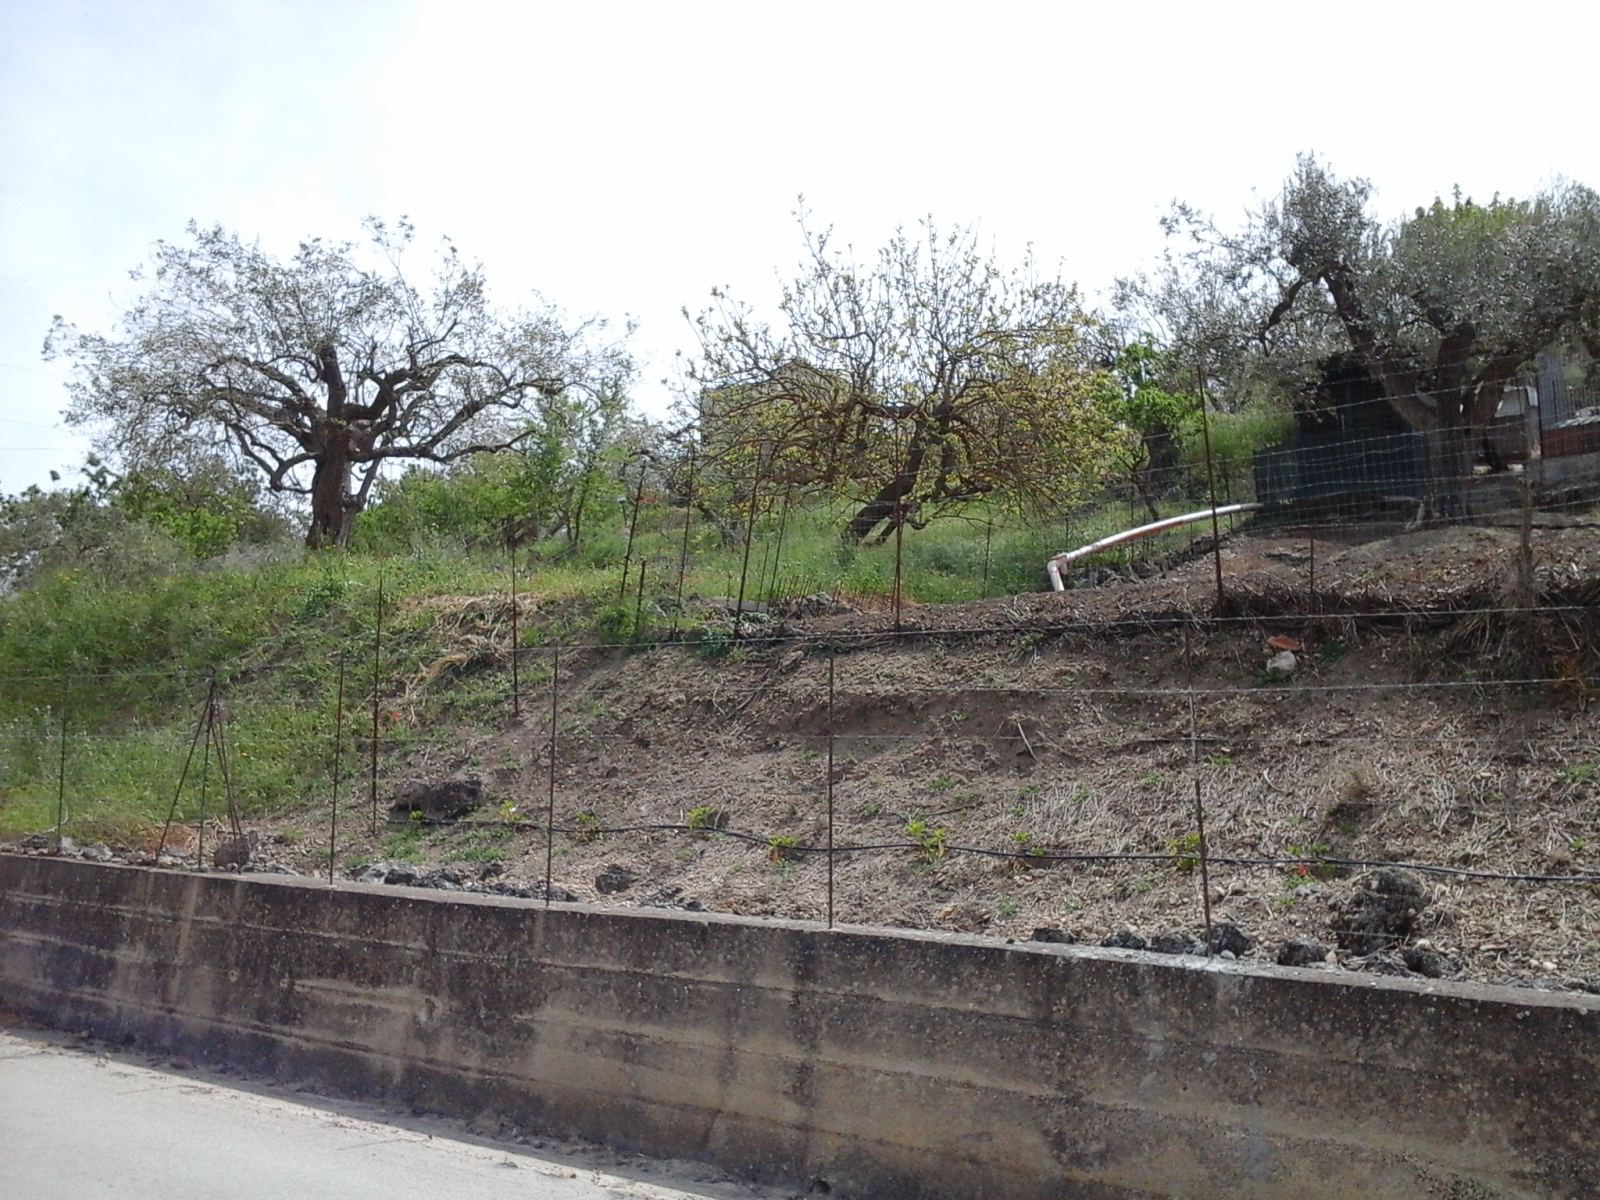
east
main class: Cropland
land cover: Nuts trees
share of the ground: > 75 %
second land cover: Other bare soil
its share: > 75 %
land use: Agriculture (excluding fallow land and kitchen gardens)
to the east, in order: Nuts trees; Other bare soil; Electric lines; Nuts trees; Fences; Other fruit trees and berries; Olive groves; Electric lines; Olive groves; Fences; Grass margins; Paved roads, cycling and walking lanes; Electric lines; Paved roads, cycling and walking lanes; Fences; Grass margins; Paved roads, cycling and walking lanes; Electric lines; Paved roads, cycling and walking lanes; Grass margins; Fences; Nuts trees; Paved roads, cycling and walking lanes; Olive groves; Electric lines; Olive groves
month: May
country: IT
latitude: 37.4040
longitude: 14.1149
